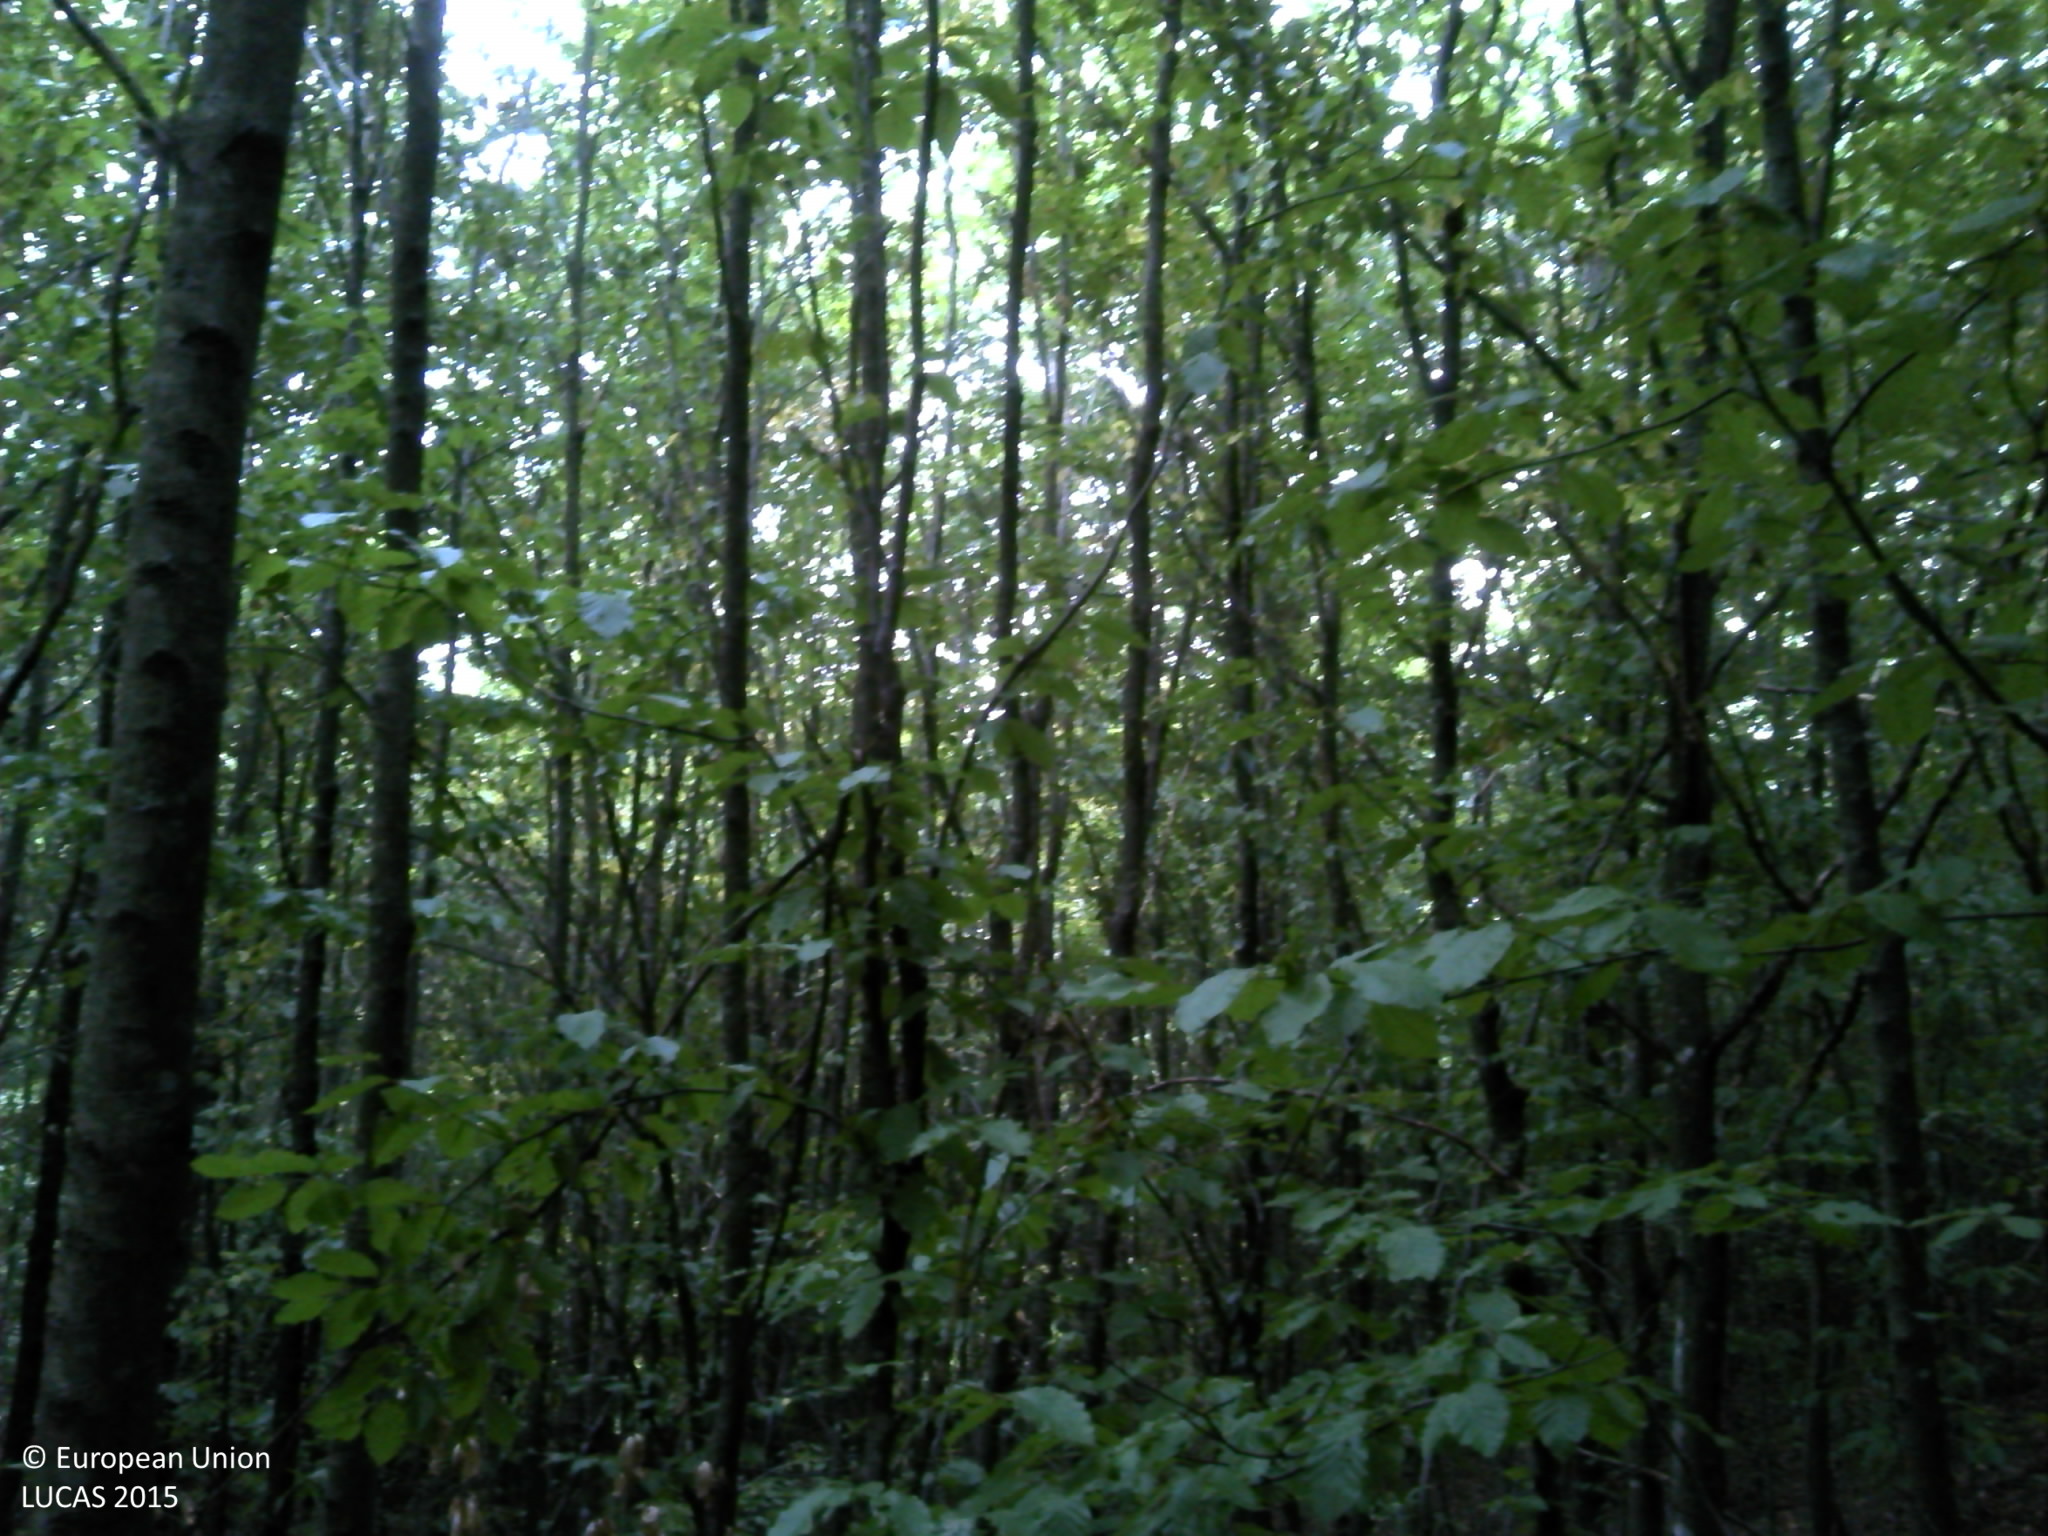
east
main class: Woodland
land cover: Broadleaved woodland
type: beech forest
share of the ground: > 75 %
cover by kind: broadleaved forest trees 100 %
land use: Forestry
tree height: < 5 m
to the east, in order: Broadleaved woodland; Ditches and canals; Grassland without tree/shrub cover; Shrubland with sparse tree cover
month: August
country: HR
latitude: 45.4146
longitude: 18.0412
